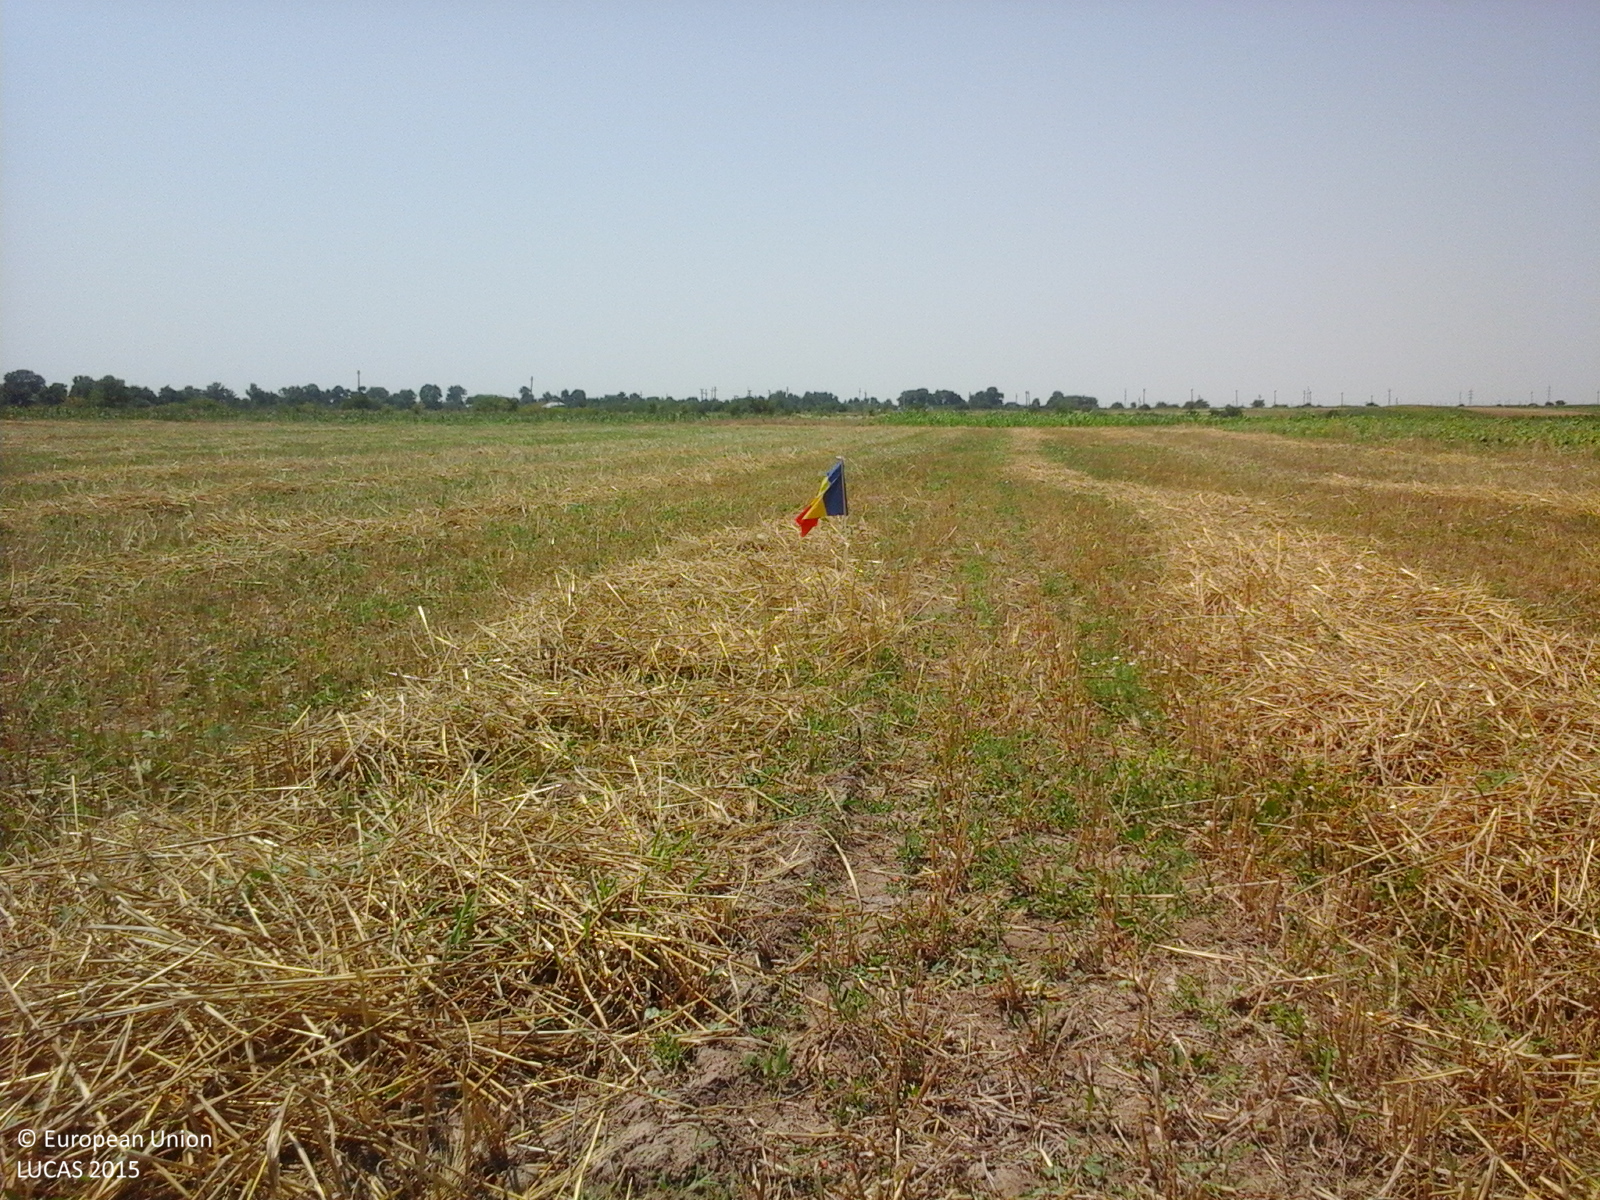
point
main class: Cropland
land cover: Barley
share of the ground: < 10 %
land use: Agriculture (excluding fallow land and kitchen gardens)
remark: Harvested field
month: July
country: RO
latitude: 44.4323
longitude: 25.3255
